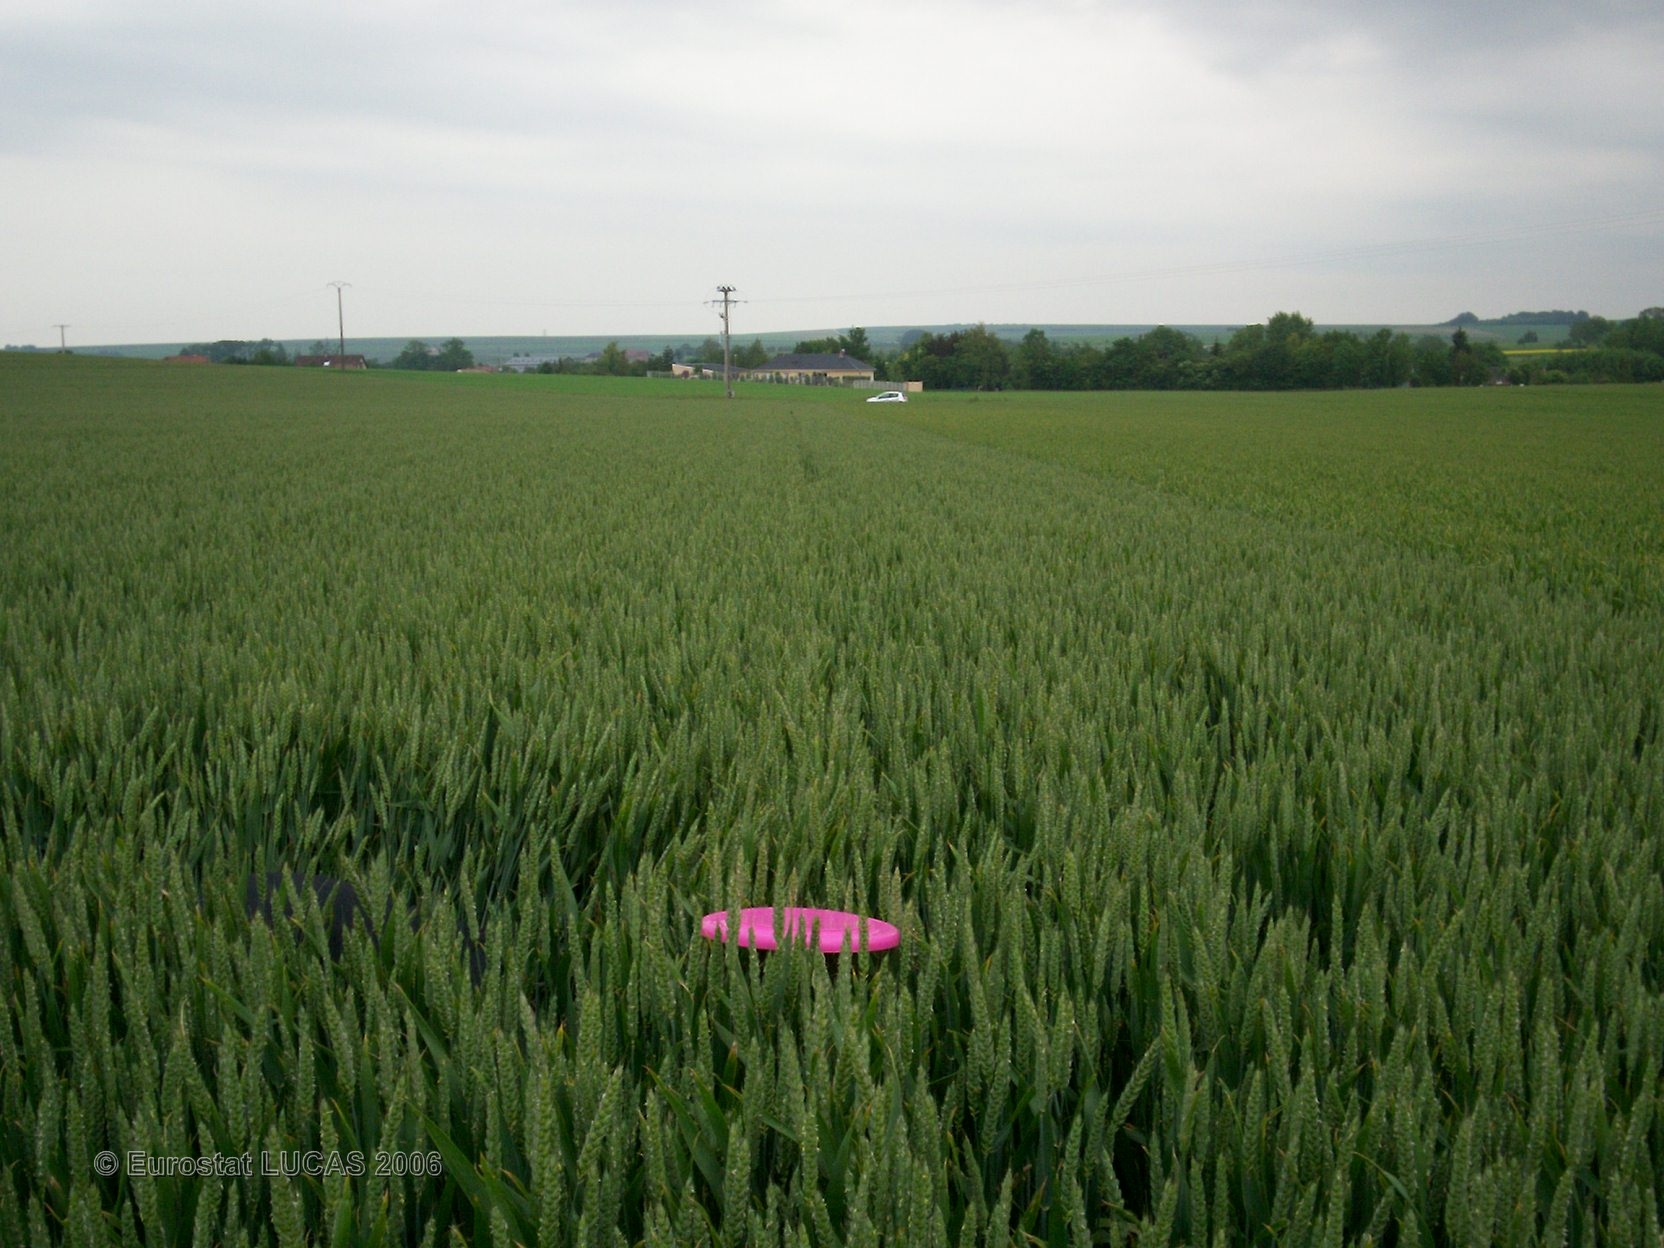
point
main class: Cropland
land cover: Common wheat
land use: Agriculture (excluding fallow land and kitchen gardens)
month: June
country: FR
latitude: 48.7529
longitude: 4.4882
